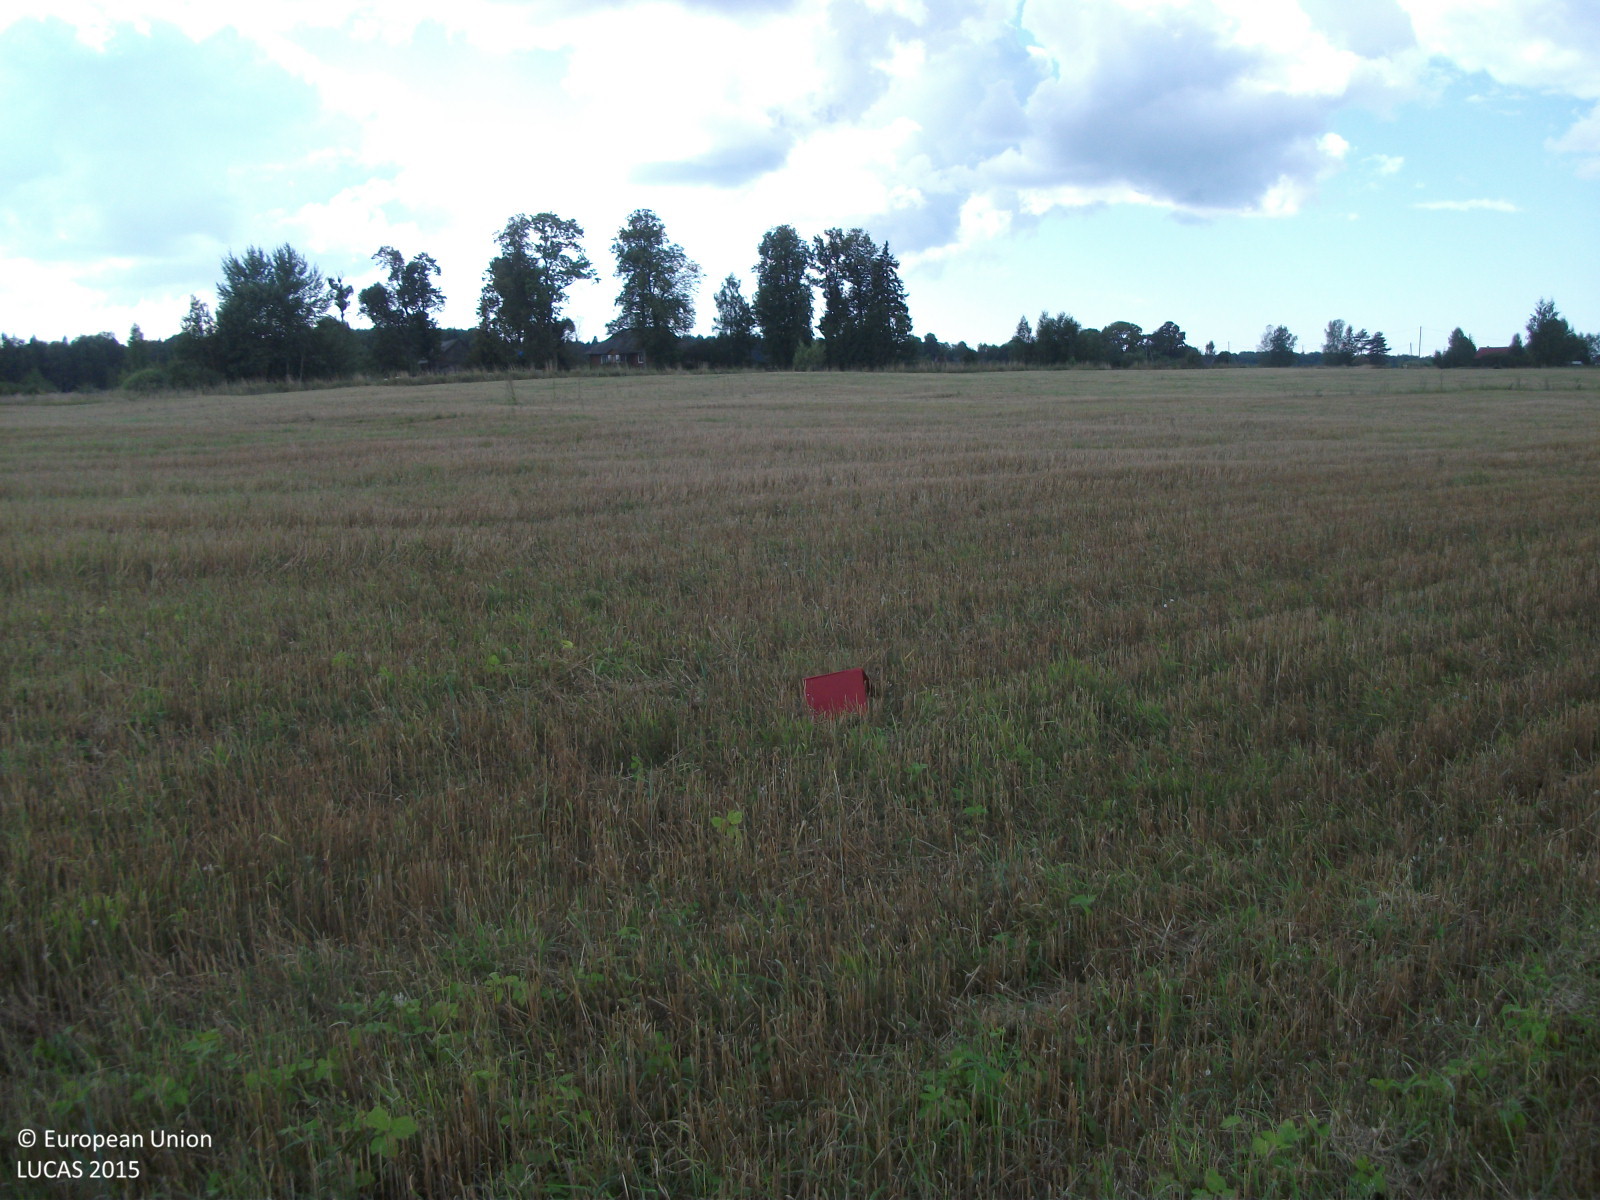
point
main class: Cropland
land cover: Common wheat
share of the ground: < 10 %
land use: Agriculture (excluding fallow land and kitchen gardens)
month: September
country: LV
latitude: 57.4589
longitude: 24.5438
